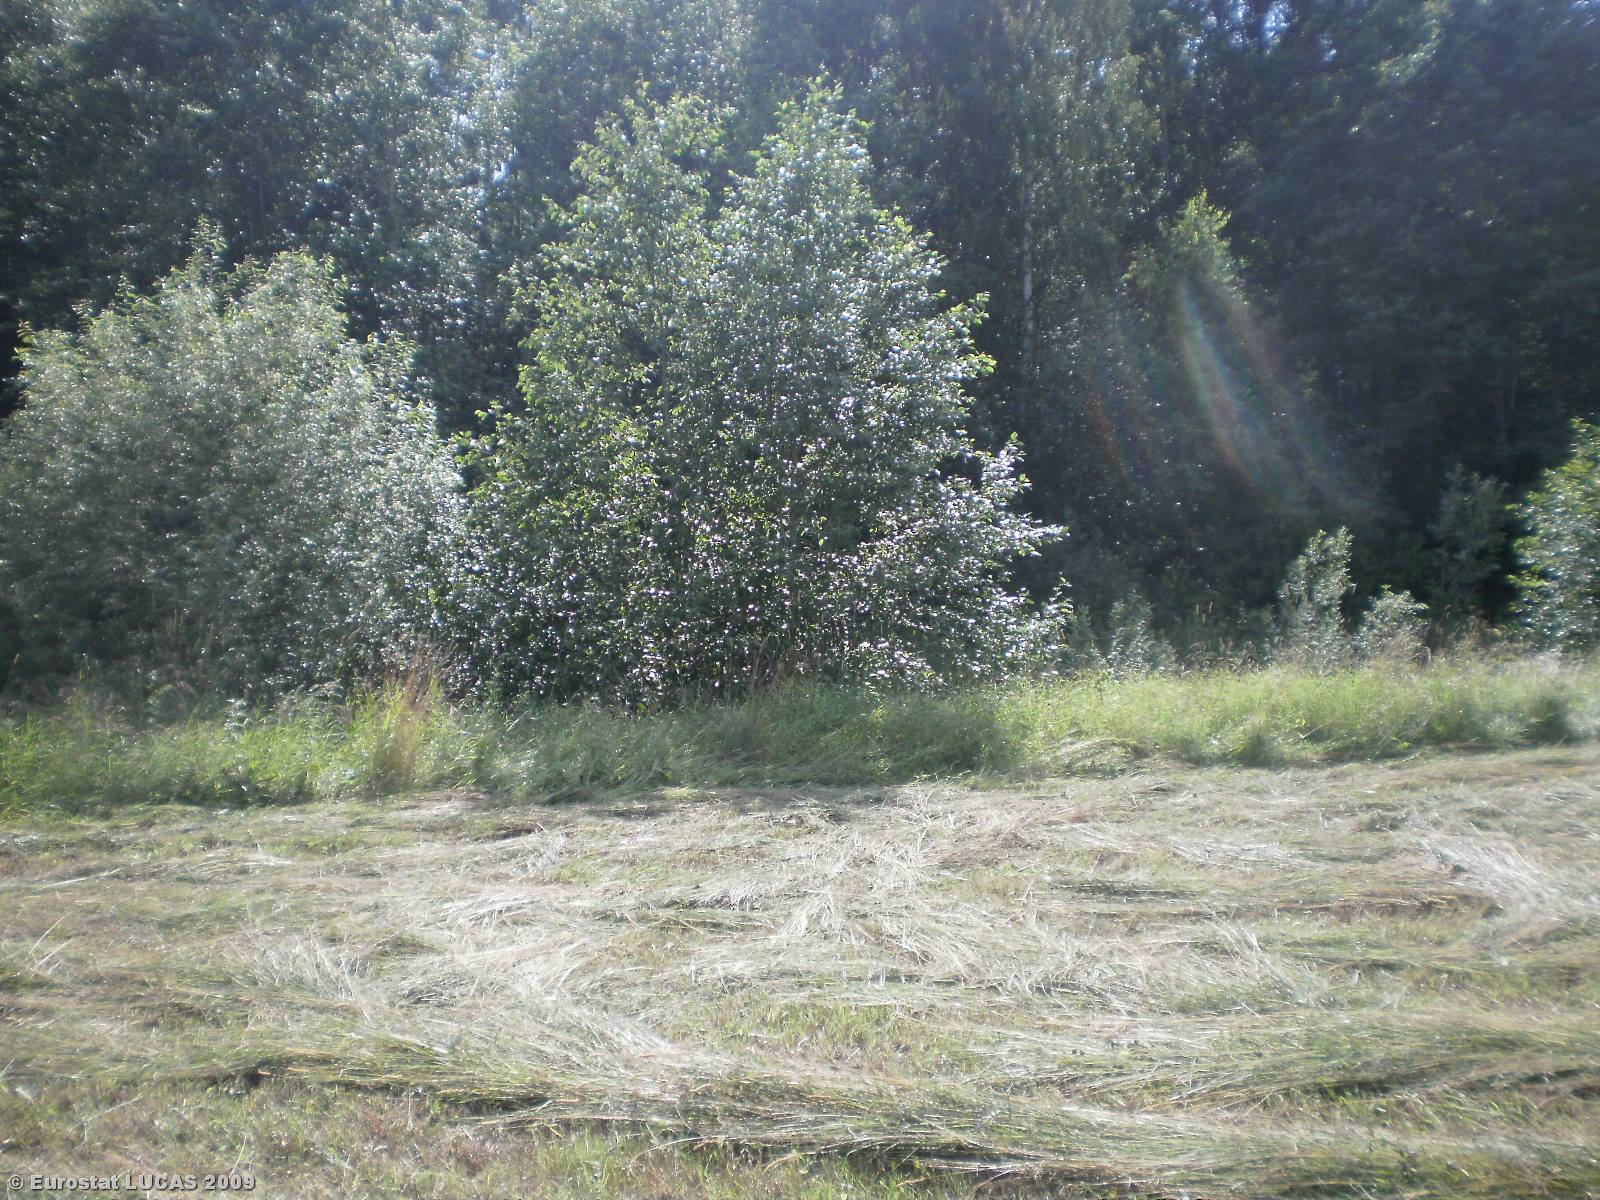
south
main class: Grassland
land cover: Grassland without tree/shrub cover
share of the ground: > 75 %
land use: Agriculture (excluding fallow land and kitchen gardens)
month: July
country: LT
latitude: 56.1273
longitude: 25.1221
